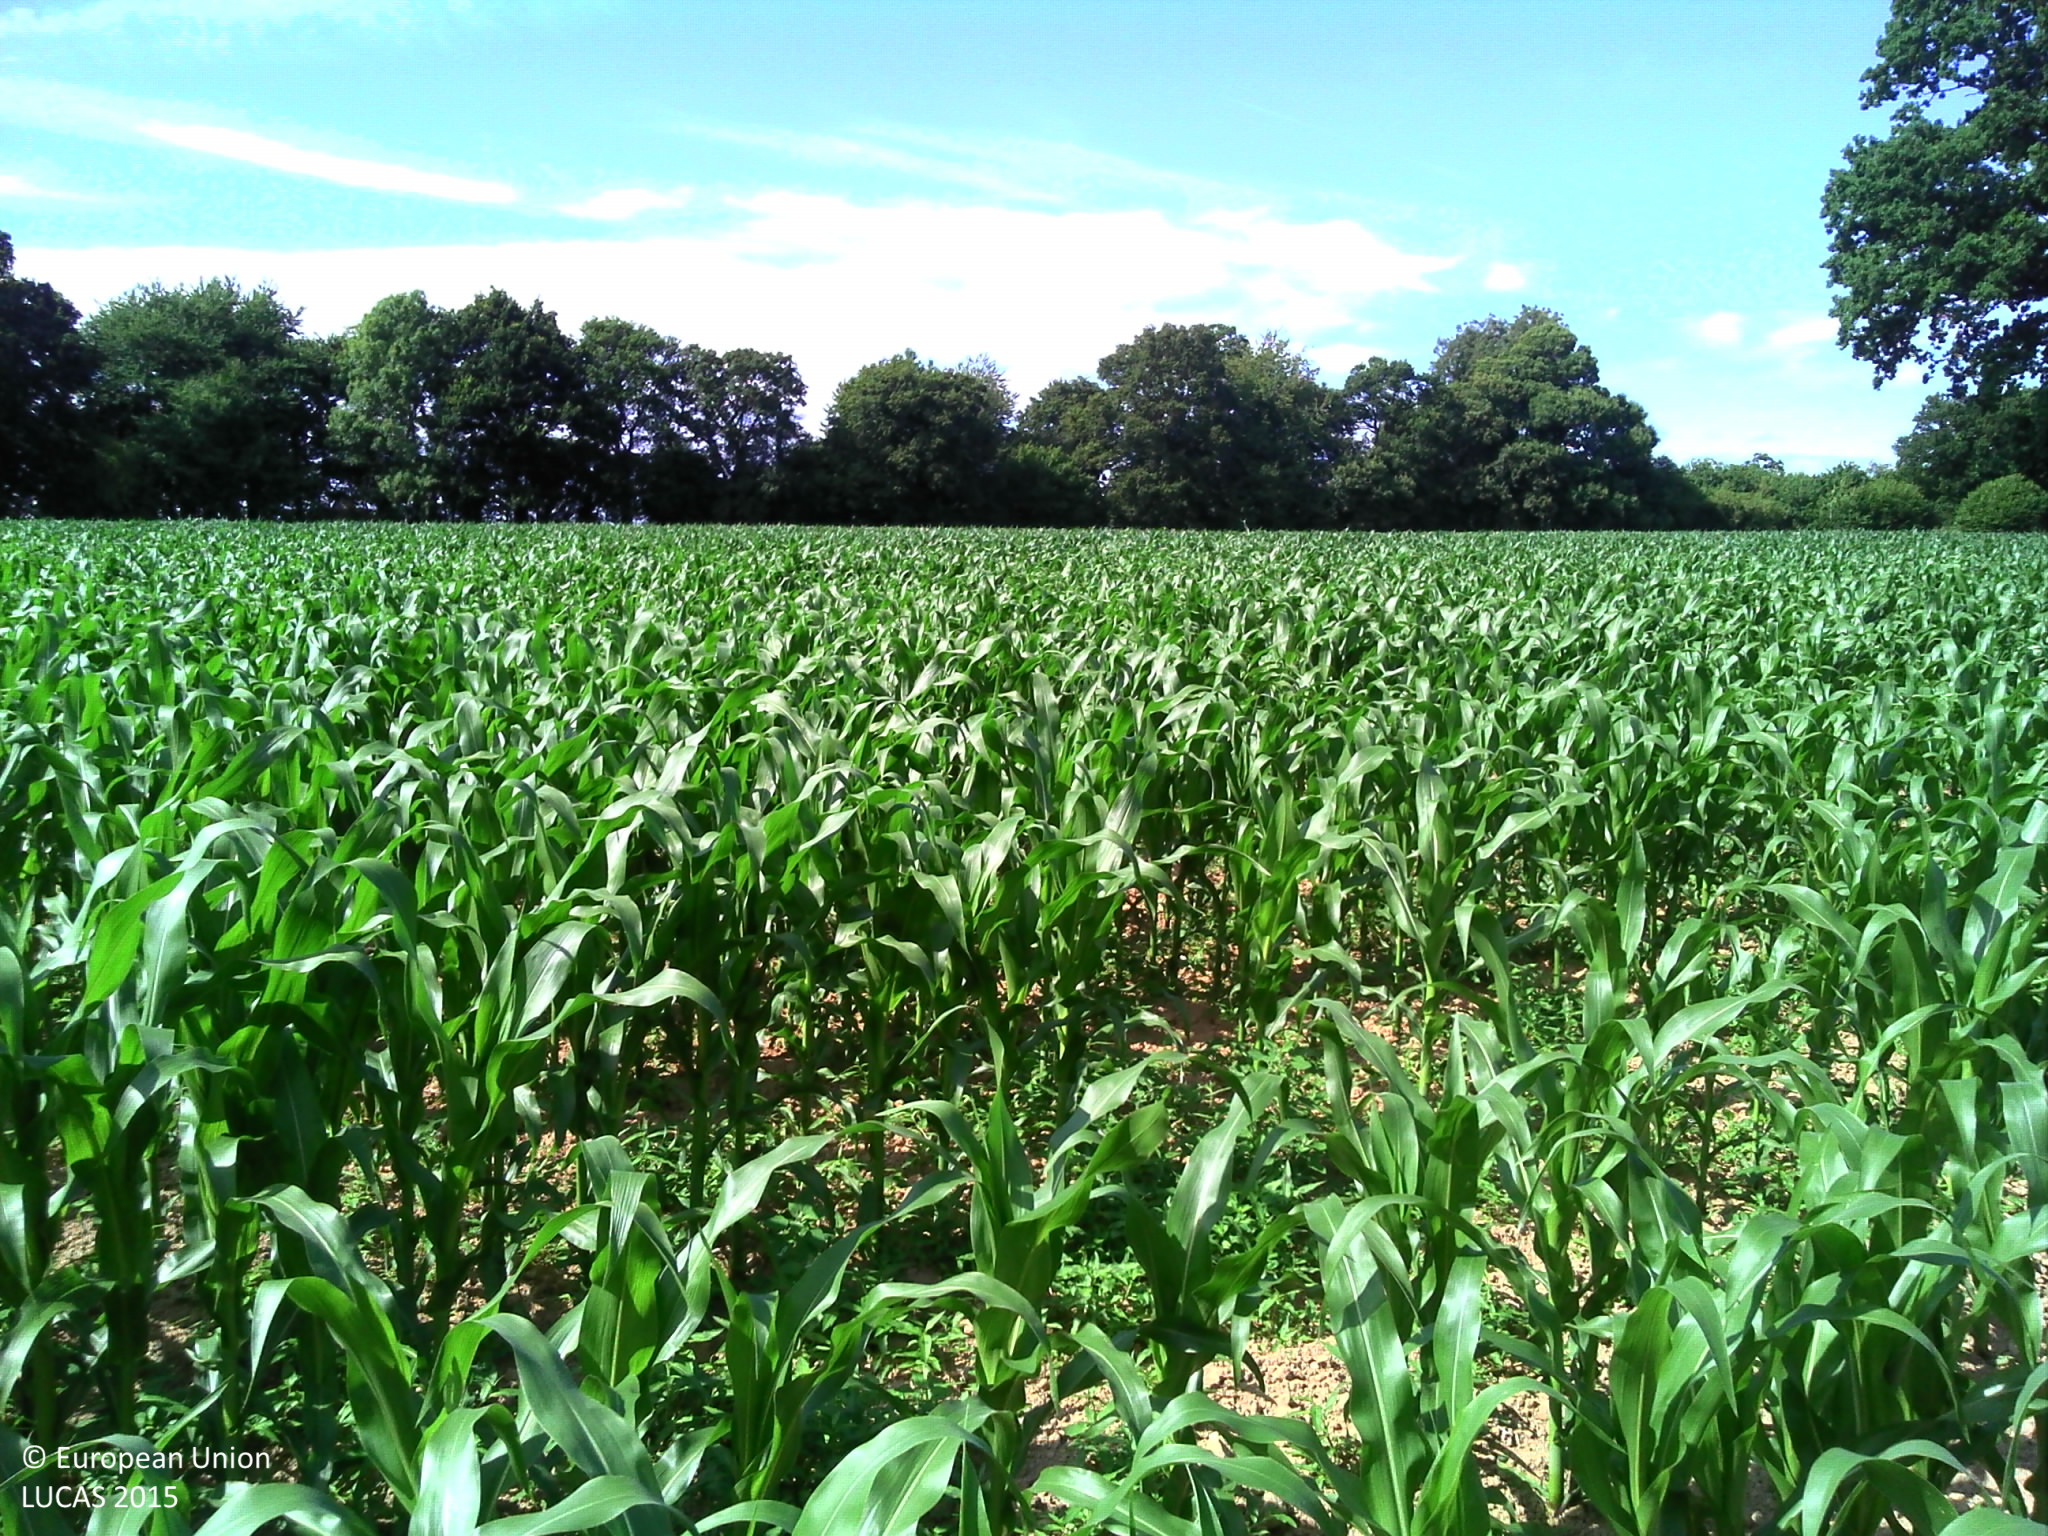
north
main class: Cropland
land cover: Maize
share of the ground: 50 - 75 %
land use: Agriculture (excluding fallow land and kitchen gardens)
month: July
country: FR
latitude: 48.9540
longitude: -1.4229
